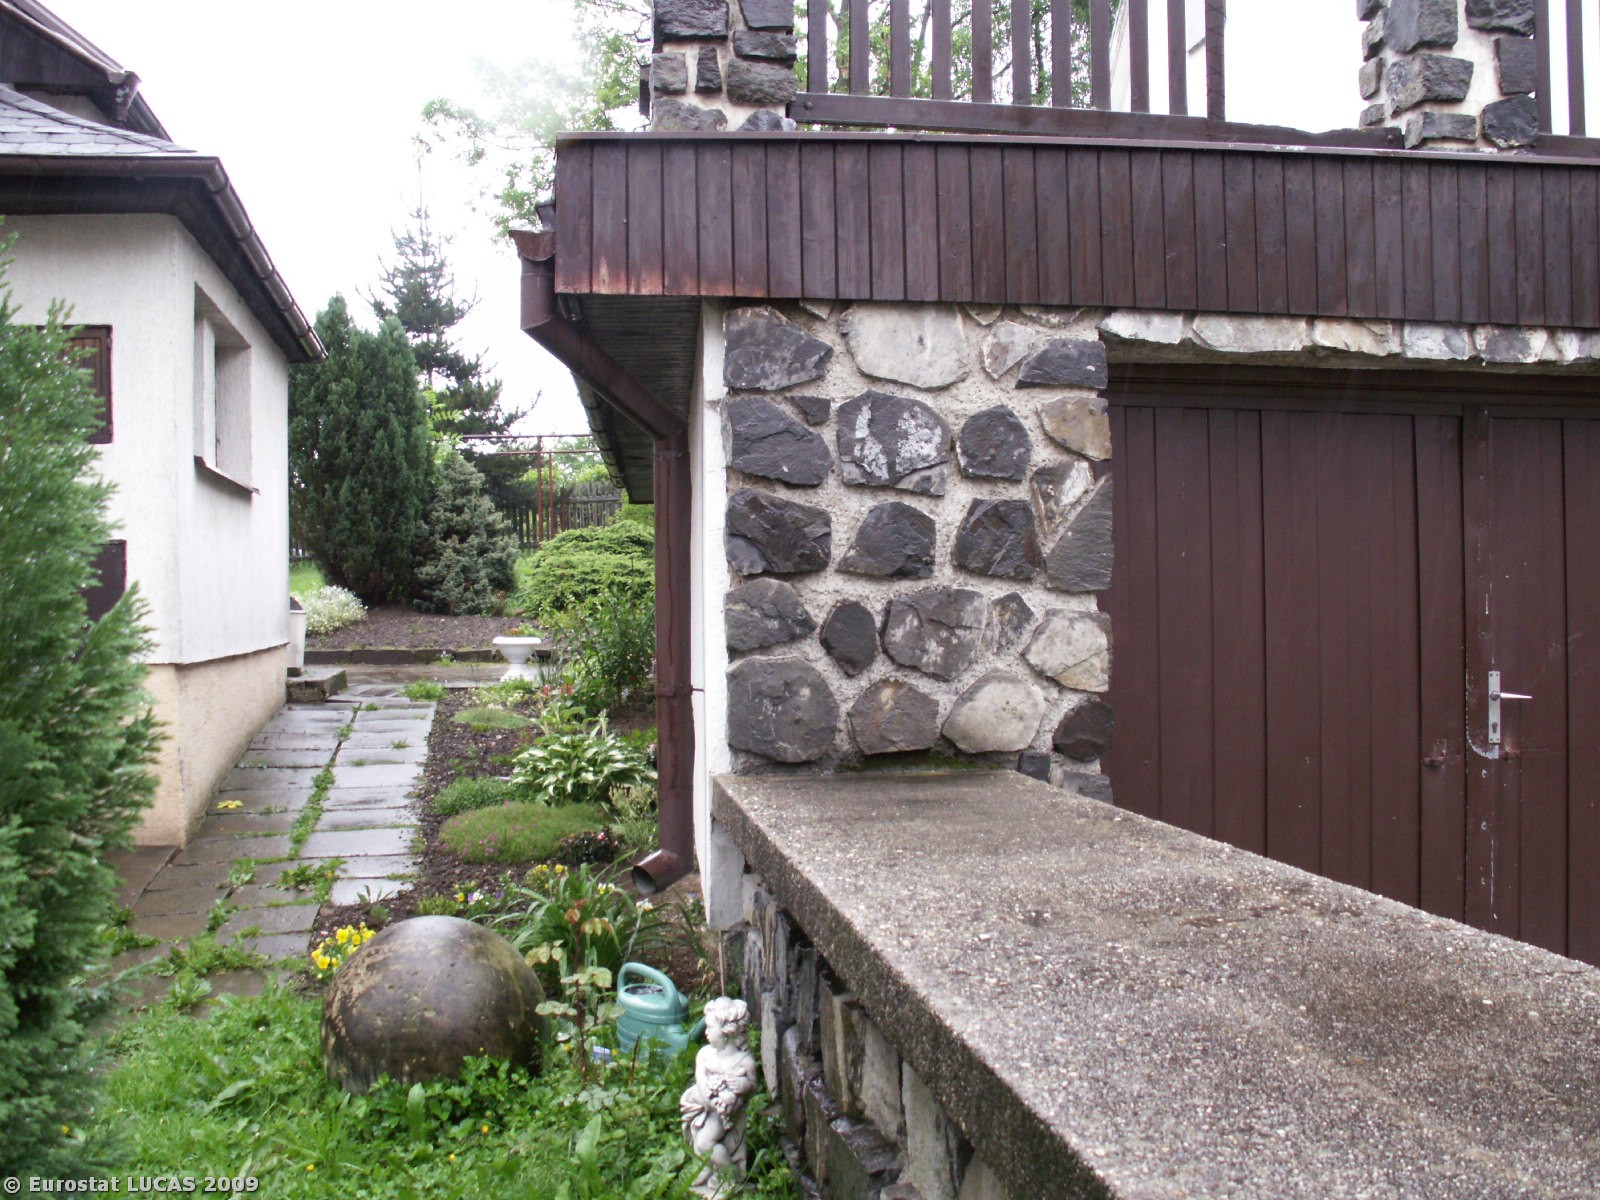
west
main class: Grassland
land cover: Grassland with sparse tree/shrub cover
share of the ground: > 75 %
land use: Residential
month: June
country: CZ
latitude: 50.4859
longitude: 13.0302
